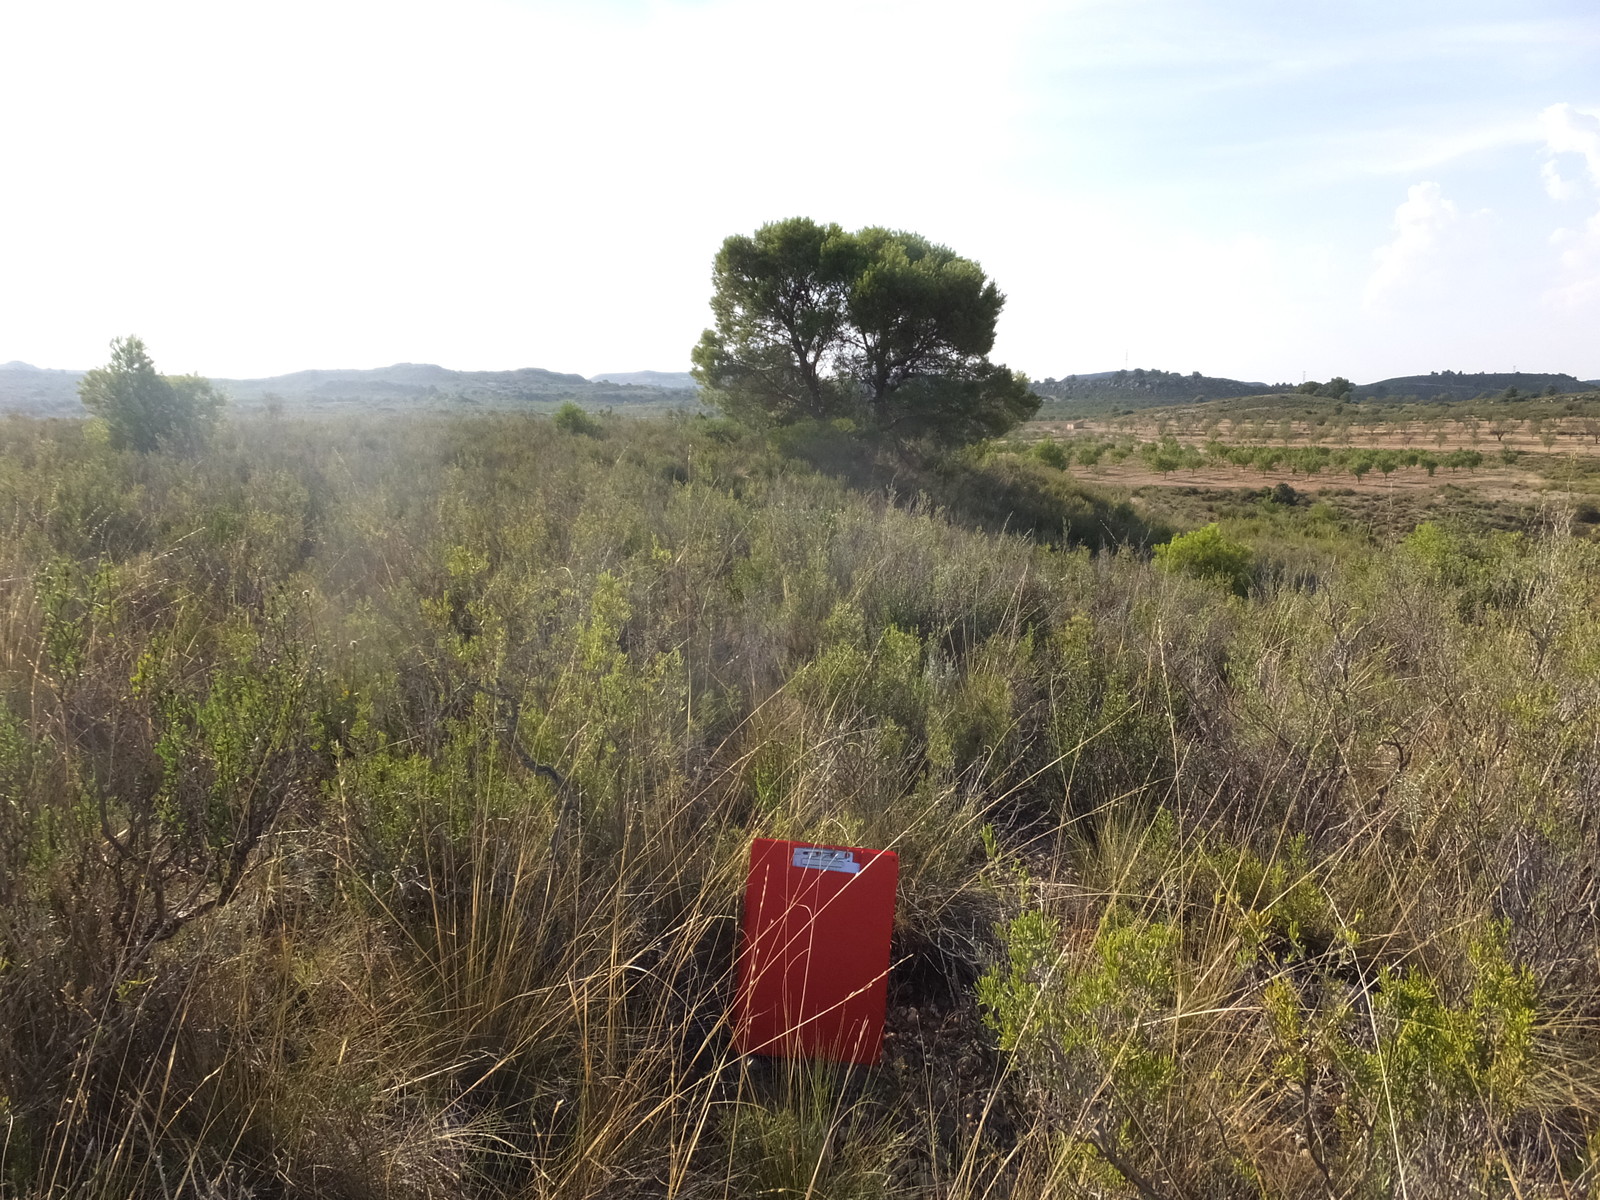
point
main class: Shrubland
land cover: Shrubland with sparse tree cover
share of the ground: > 75 %
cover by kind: shrubs 55 %, herbaceous plants 40 %, coniferous forest trees 5 %
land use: Semi-natural and natural areas not in use
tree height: < 5 m
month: July
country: ES
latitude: 41.1597
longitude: 0.2053
